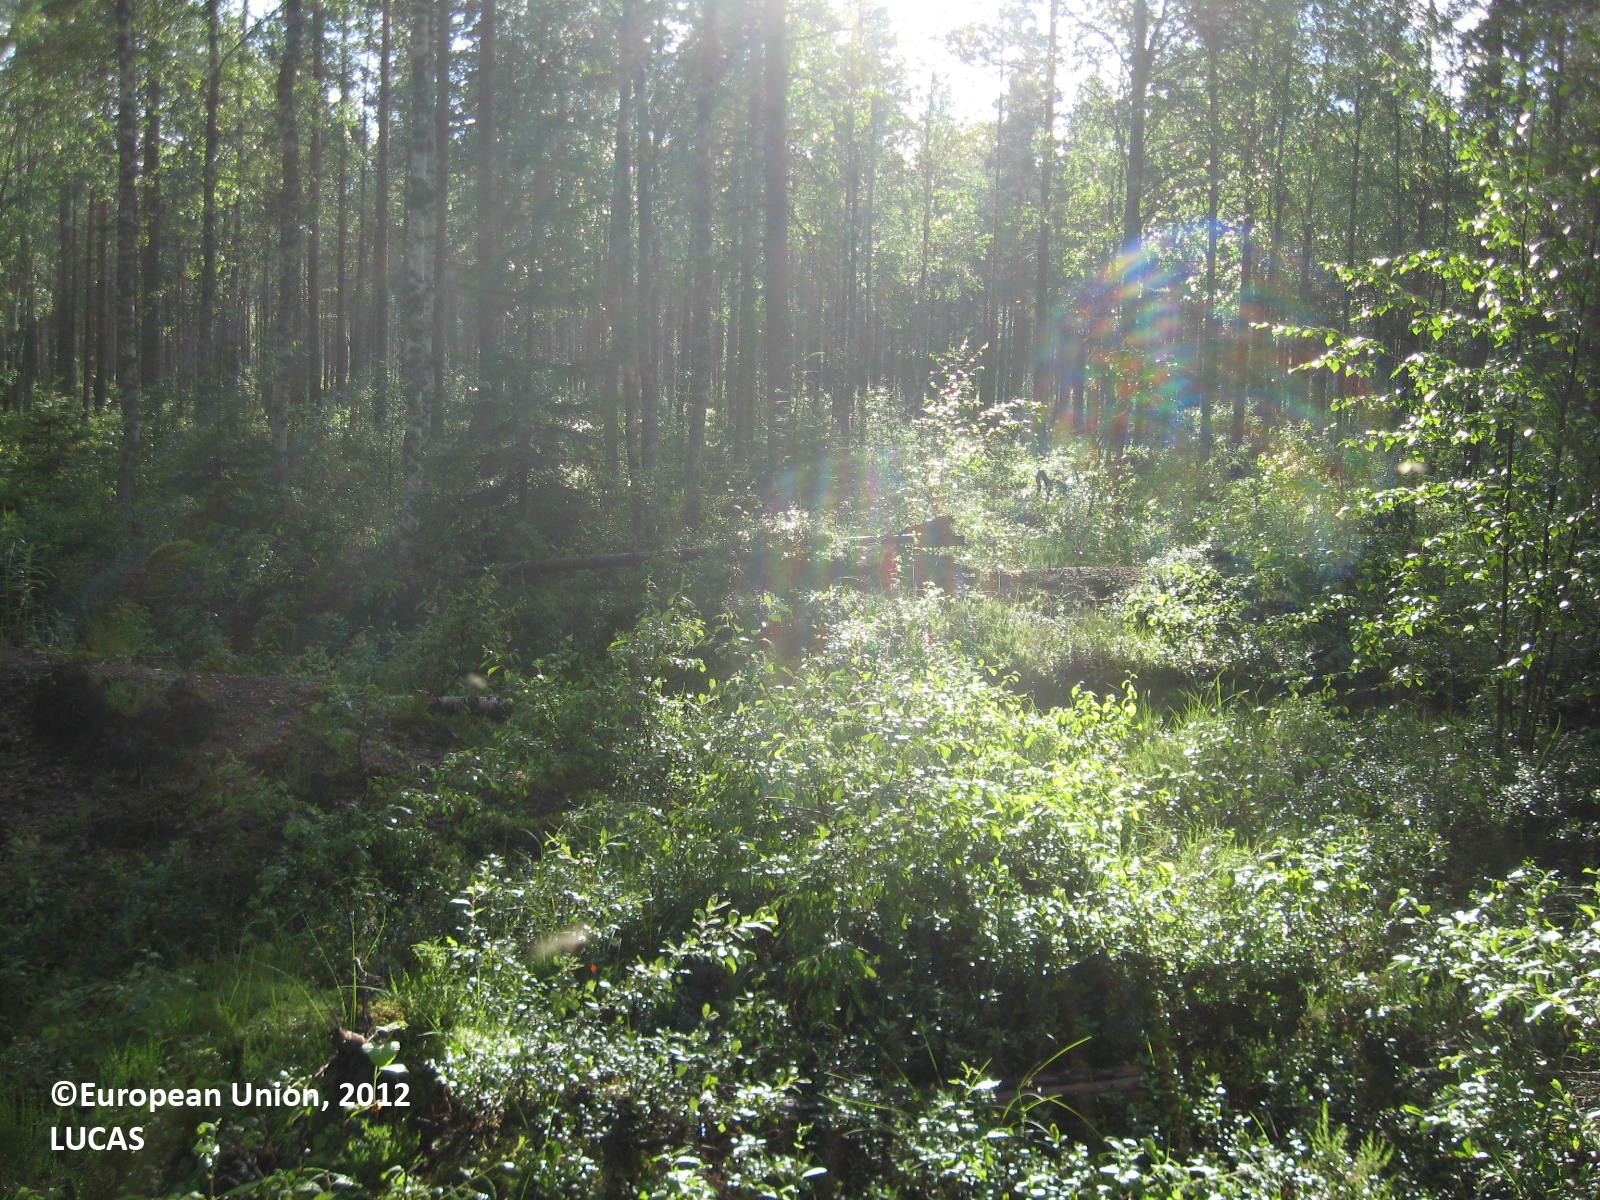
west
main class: Woodland
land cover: Pine dominated mixed woodland
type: boreal forest
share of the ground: > 75 %
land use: Forestry
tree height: > 5 m
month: July
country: FI
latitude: 62.2702
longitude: 22.5220
